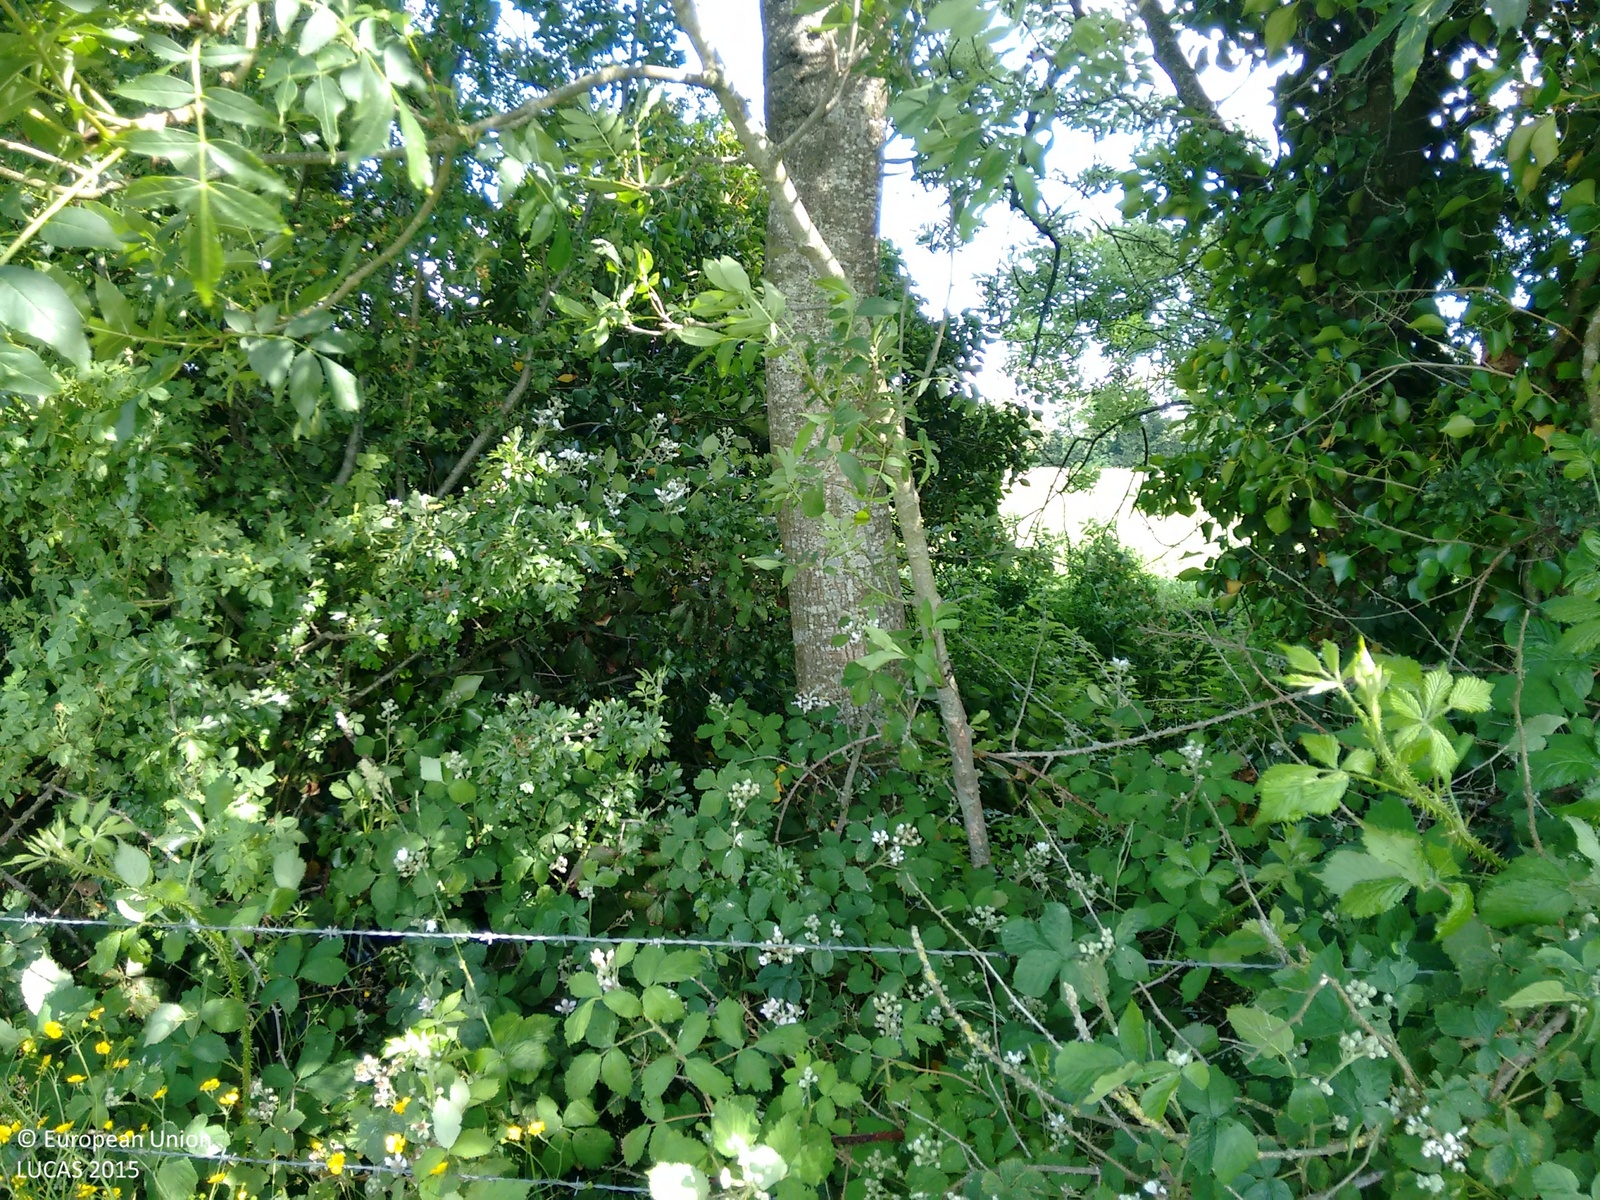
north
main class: Grassland
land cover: Grassland without tree/shrub cover
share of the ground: > 75 %
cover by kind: herbaceous plants 100 %
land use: Agriculture (excluding fallow land and kitchen gardens)
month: June
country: IE
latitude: 53.6639
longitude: -6.7041
